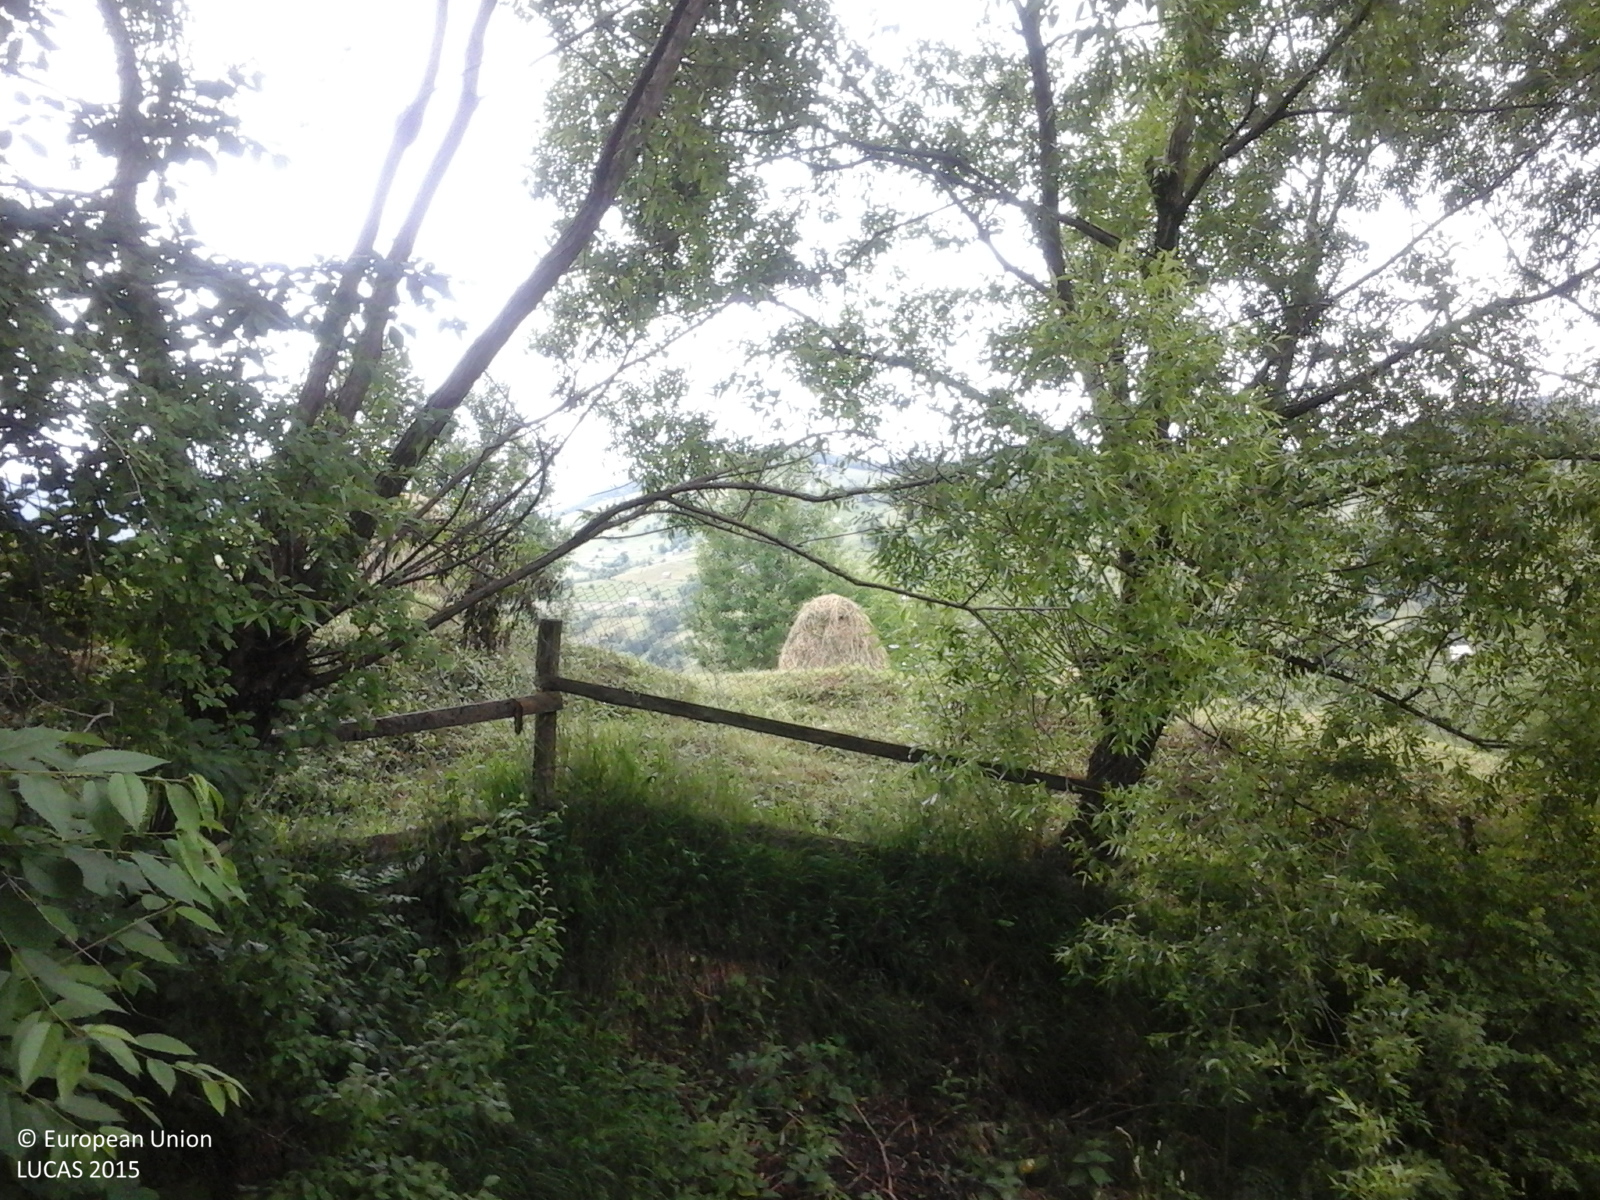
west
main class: Grassland
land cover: Grassland without tree/shrub cover
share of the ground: > 75 %
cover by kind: herbaceous plants 100 %
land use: Agriculture (excluding fallow land and kitchen gardens)
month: June
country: RO
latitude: 47.4963
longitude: 25.8004
